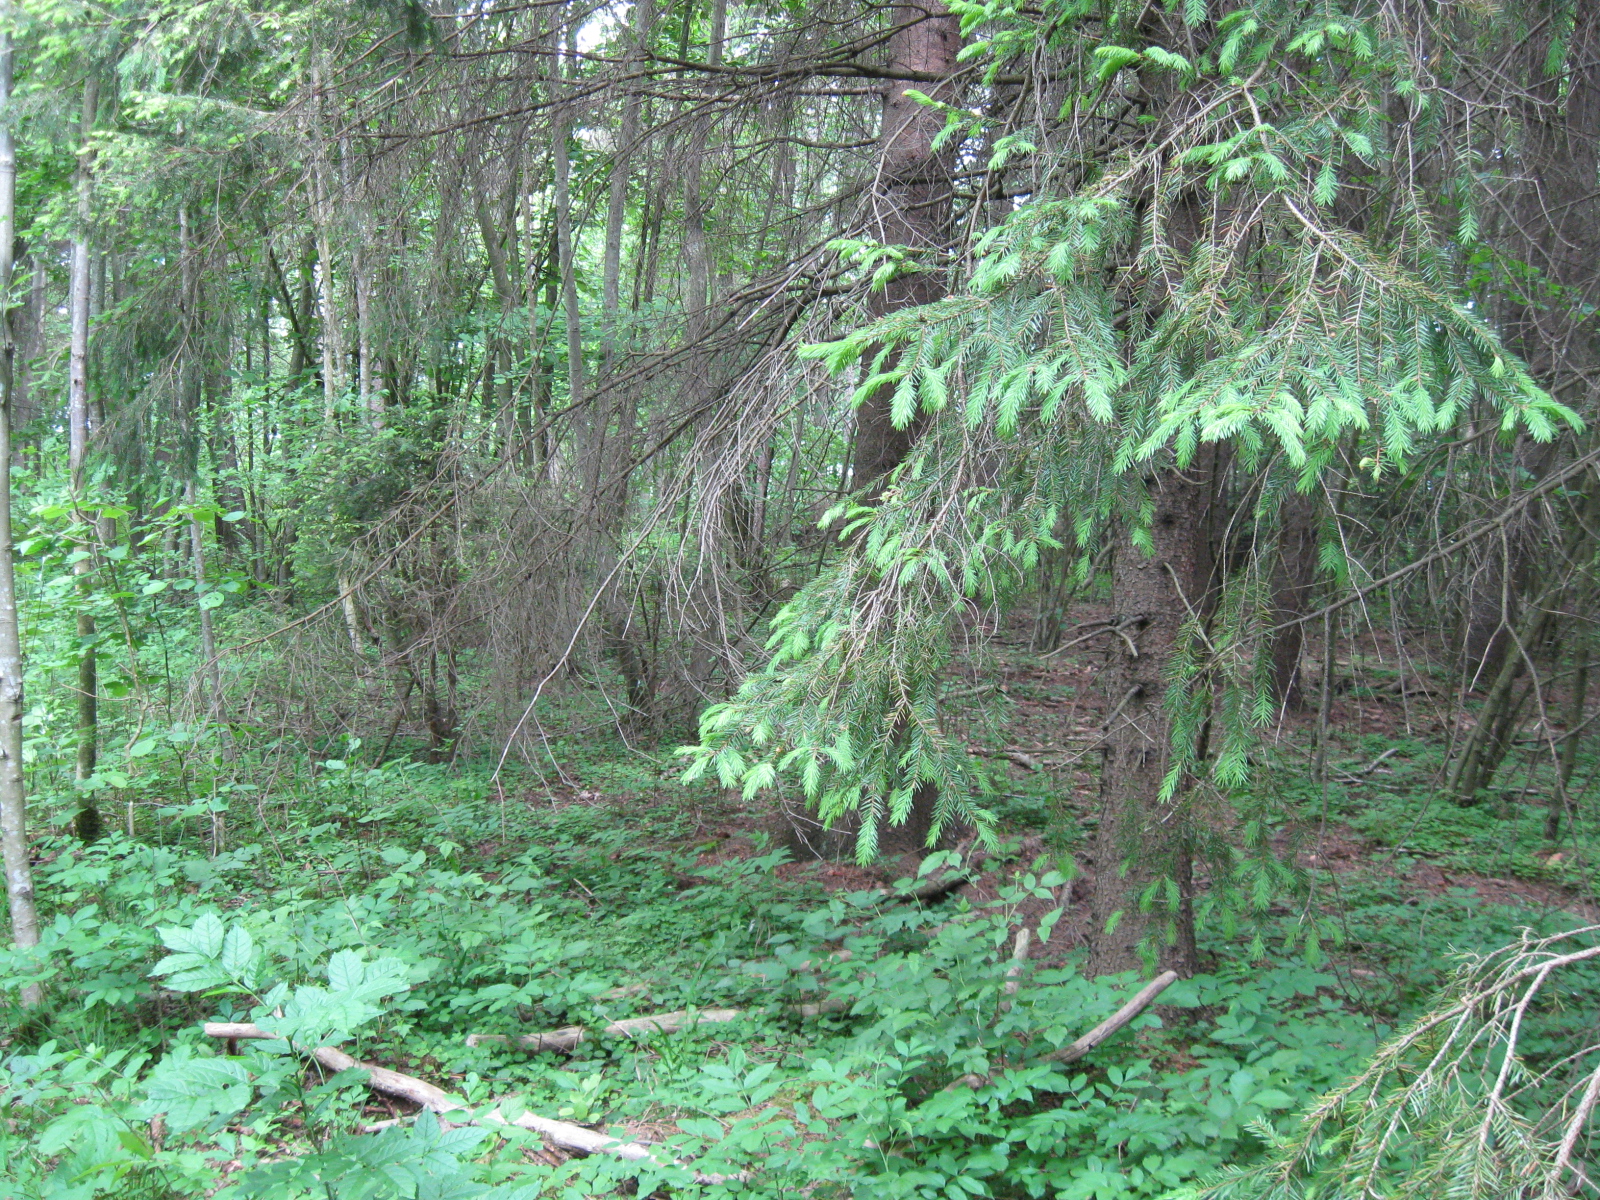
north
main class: Woodland
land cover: Spruce dominated mixed woodland
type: hemiboreal forest and nemoral coniferous forest and mixed broadleaved-coniferous forest
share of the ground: > 75 %
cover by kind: broadleaved forest trees 55 %, coniferous forest trees 35 %, herbaceous plants 10 %
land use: Forestry
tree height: > 5 m
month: June
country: LT
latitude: 55.0309
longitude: 23.8393
